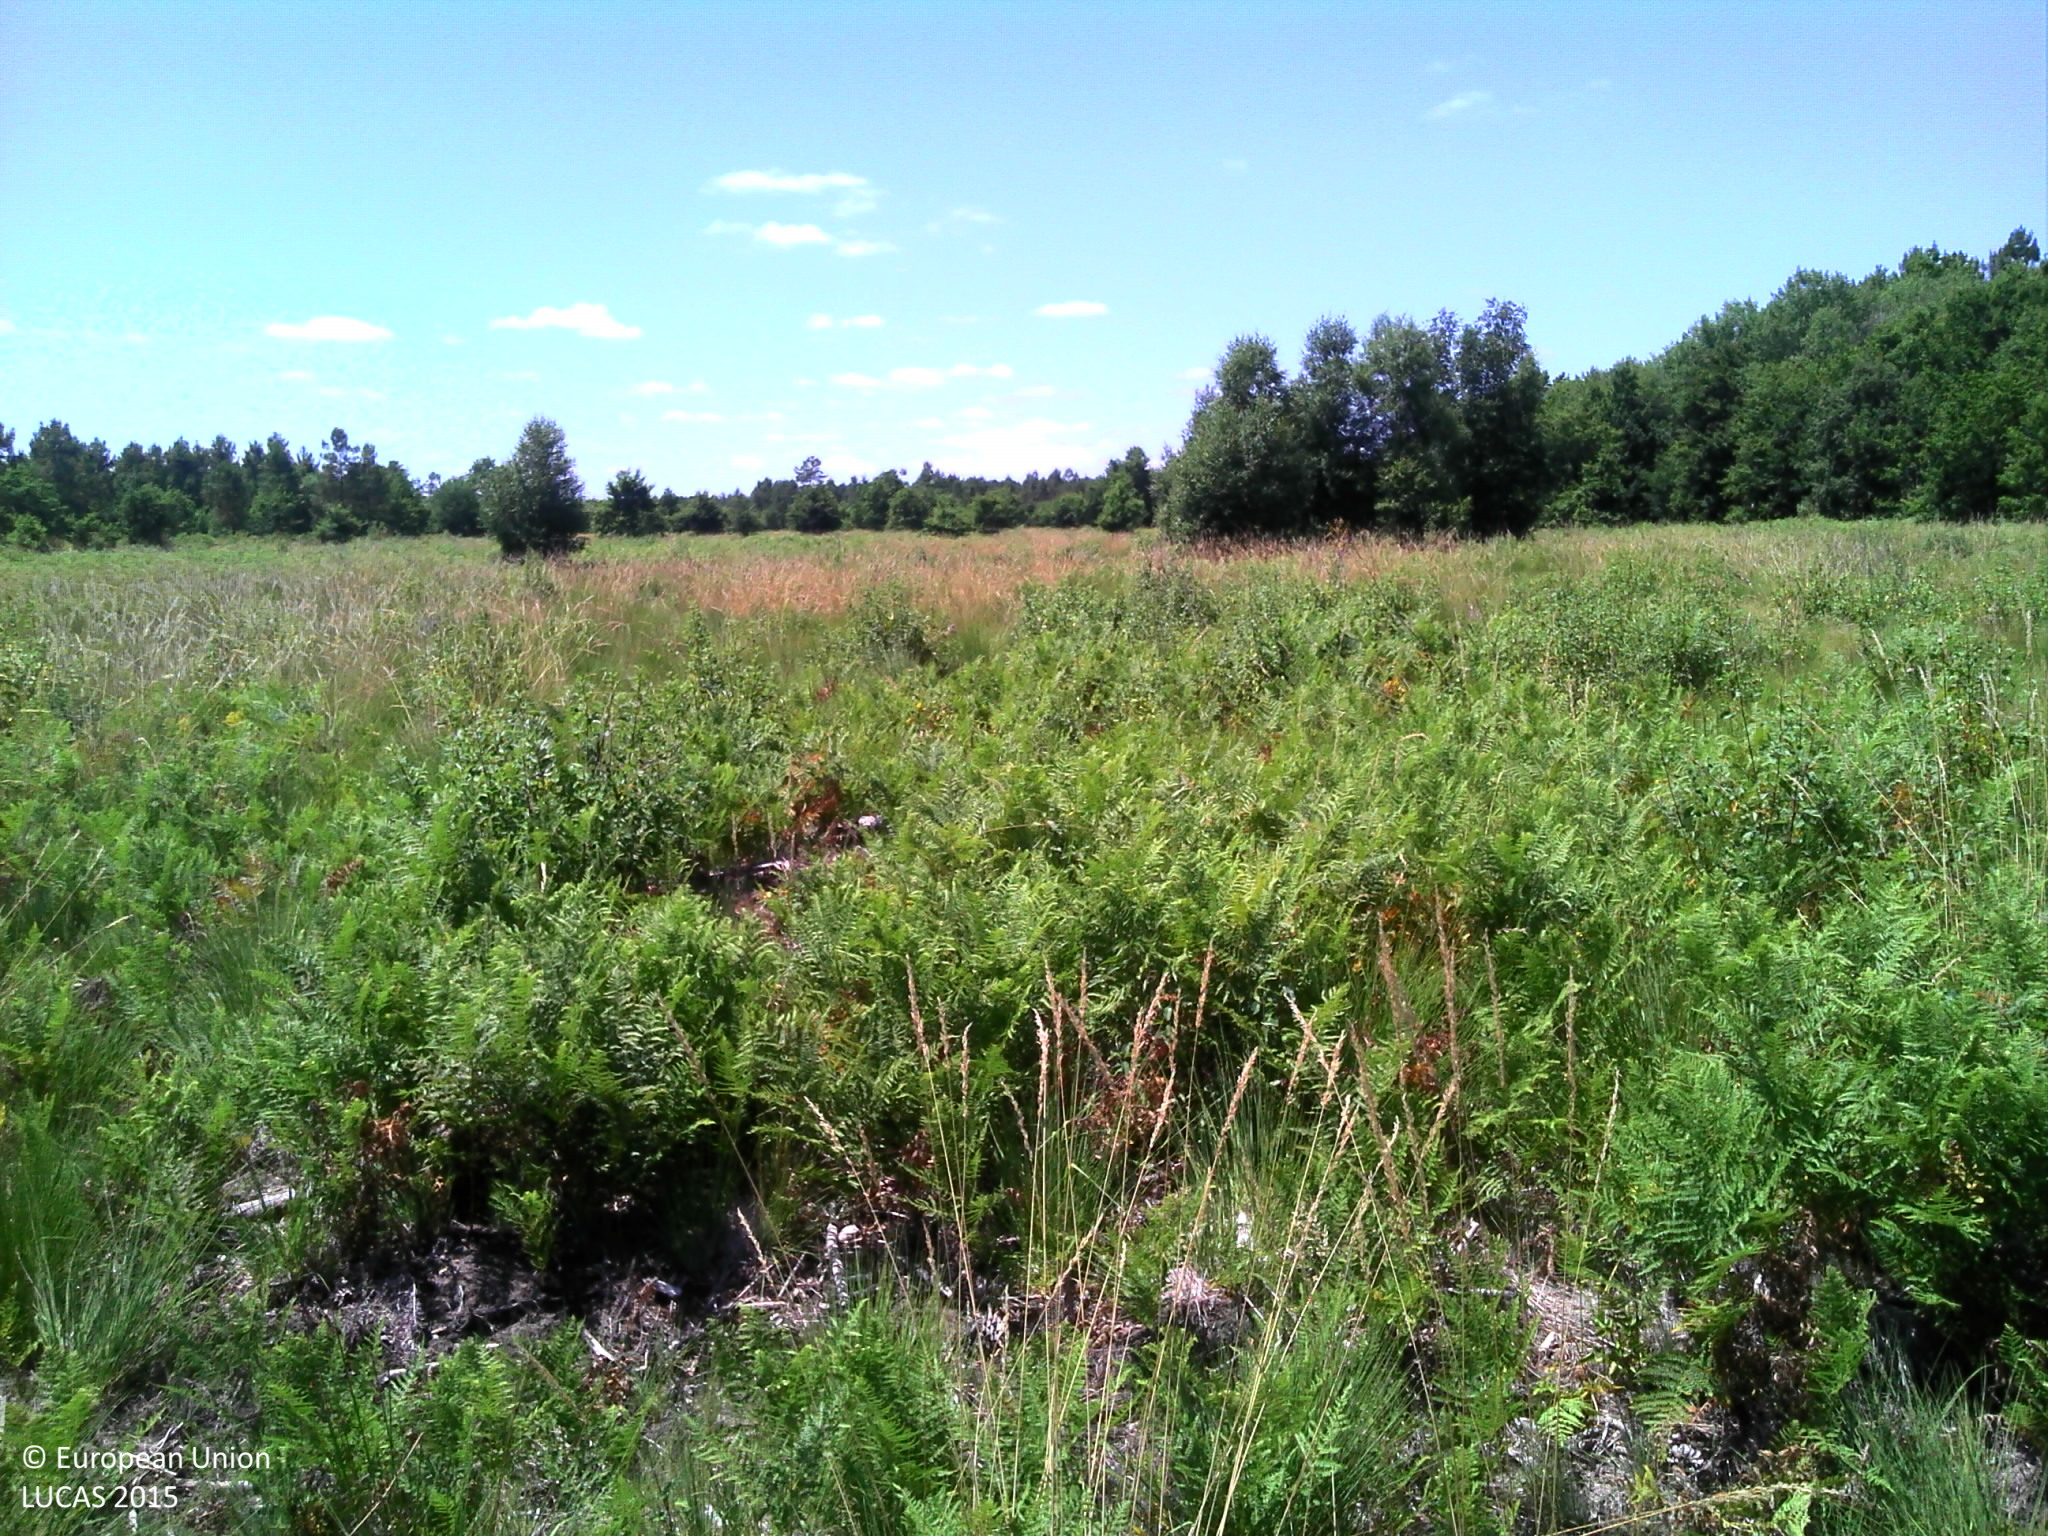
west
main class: Shrubland
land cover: Shrubland without tree cover
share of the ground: > 75 %
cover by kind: shrubs 100 %
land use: Forestry
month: July
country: FR
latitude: 44.2170
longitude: -0.8440
